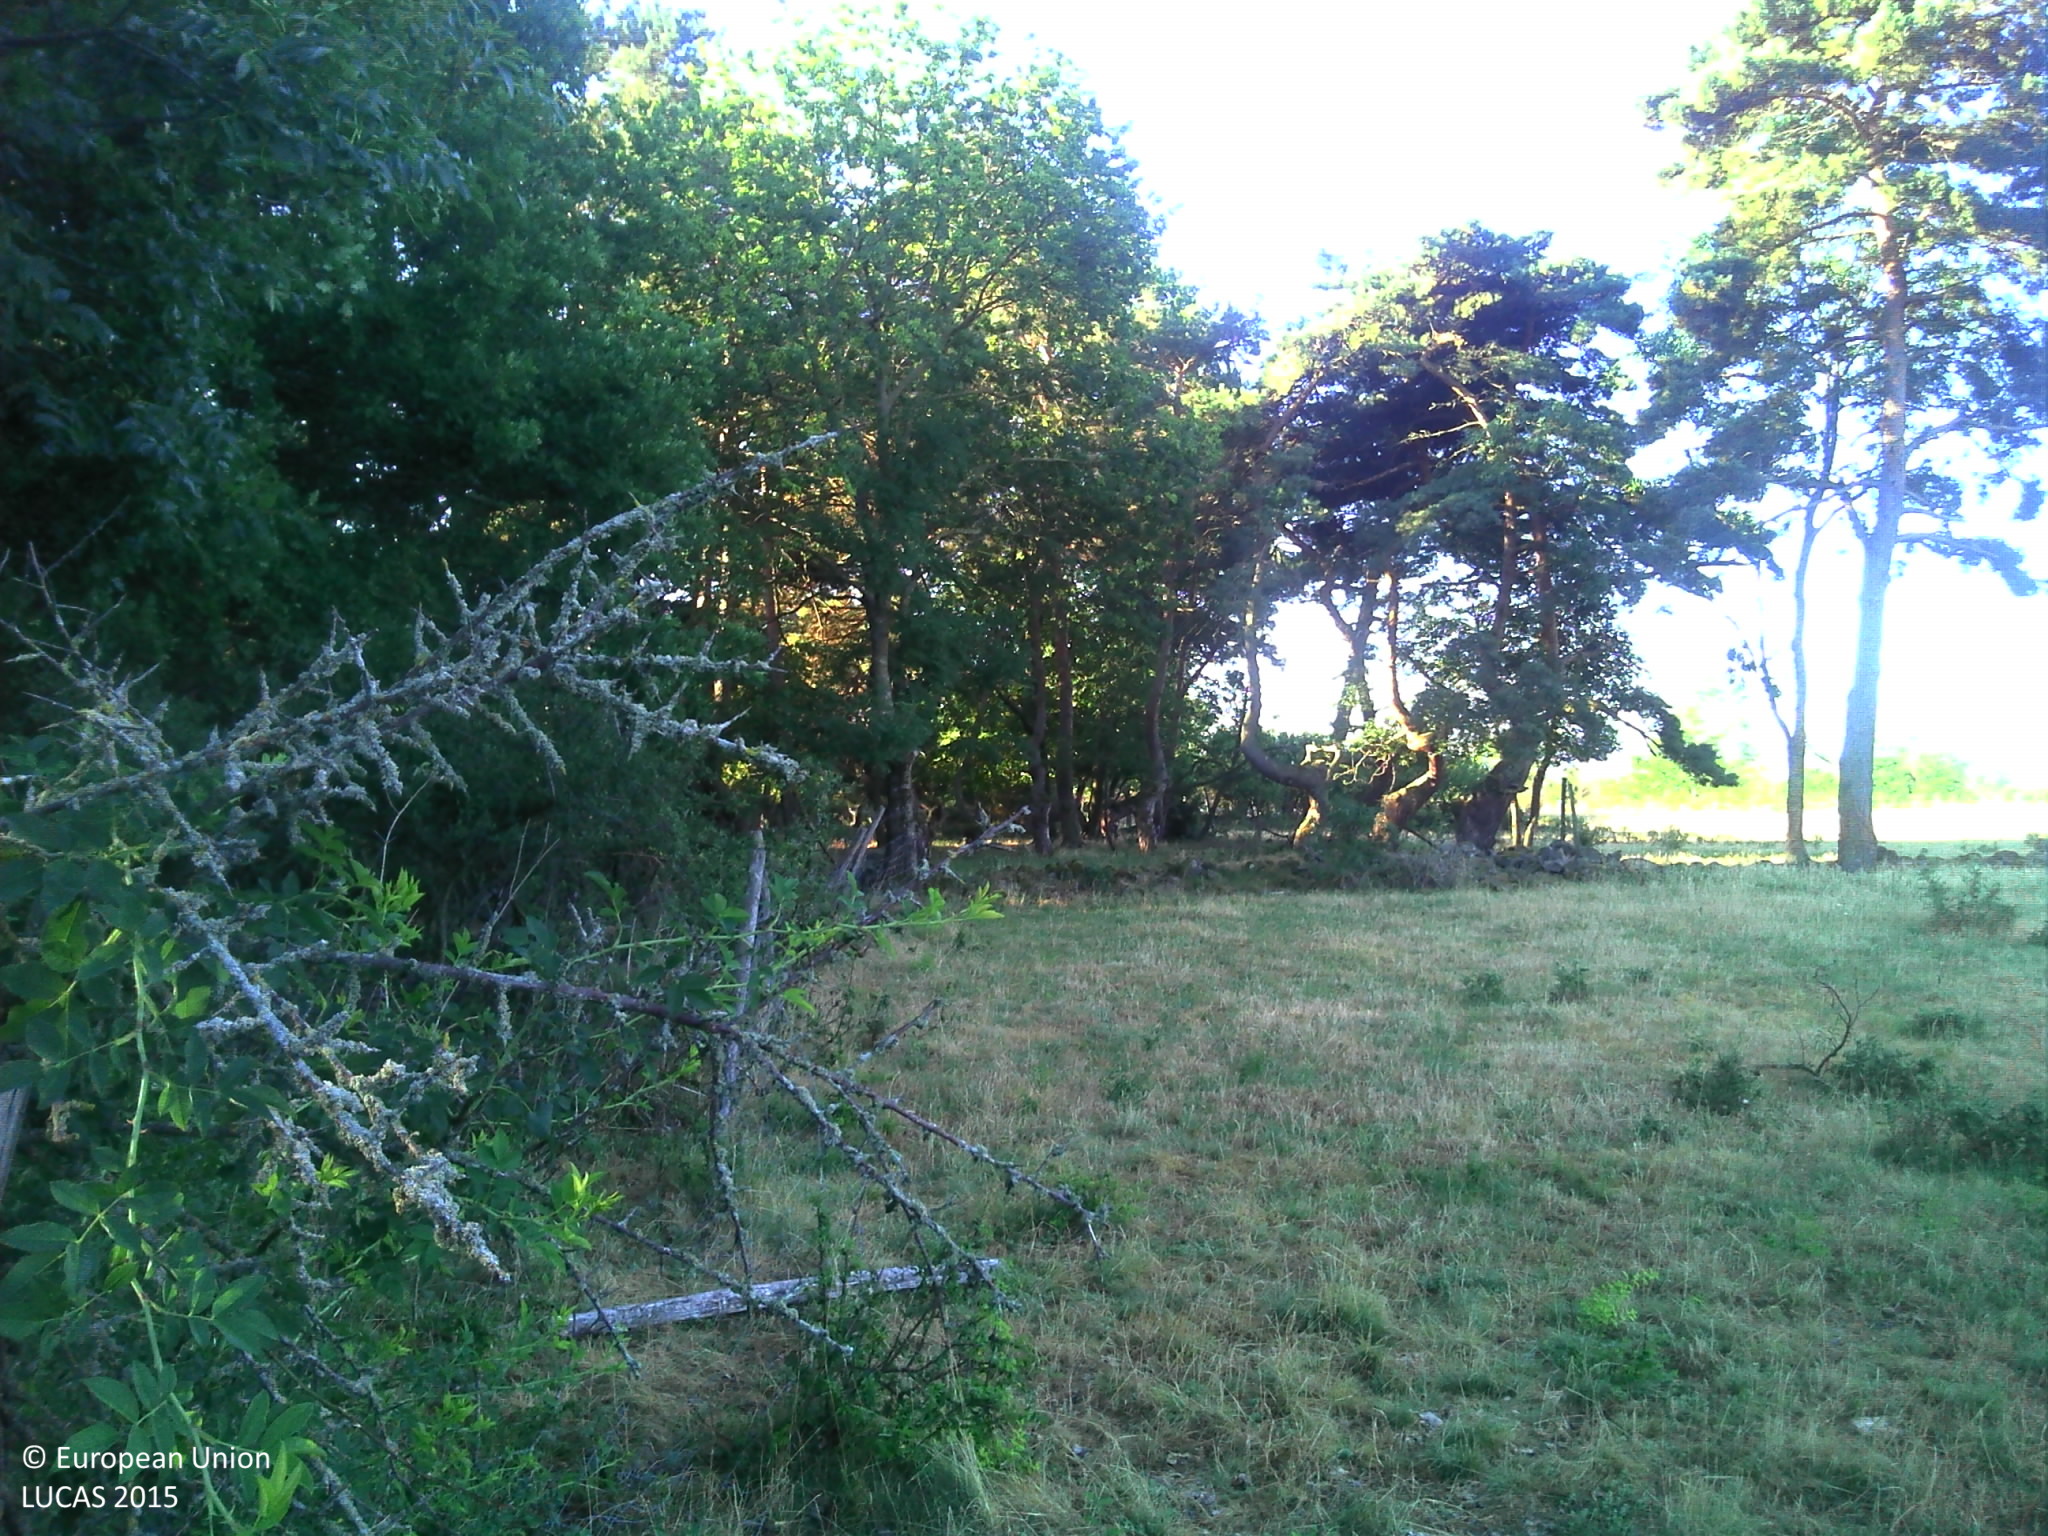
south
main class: Woodland
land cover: Pine dominated mixed woodland
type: acidophilous oak and oak-birch forest
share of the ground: > 75 %
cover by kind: coniferous forest trees 60 %, broadleaved forest trees 20 %, herbaceous plants 20 %
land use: Forestry
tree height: > 5 m
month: July
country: FR
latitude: 45.0882
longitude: 3.8164
